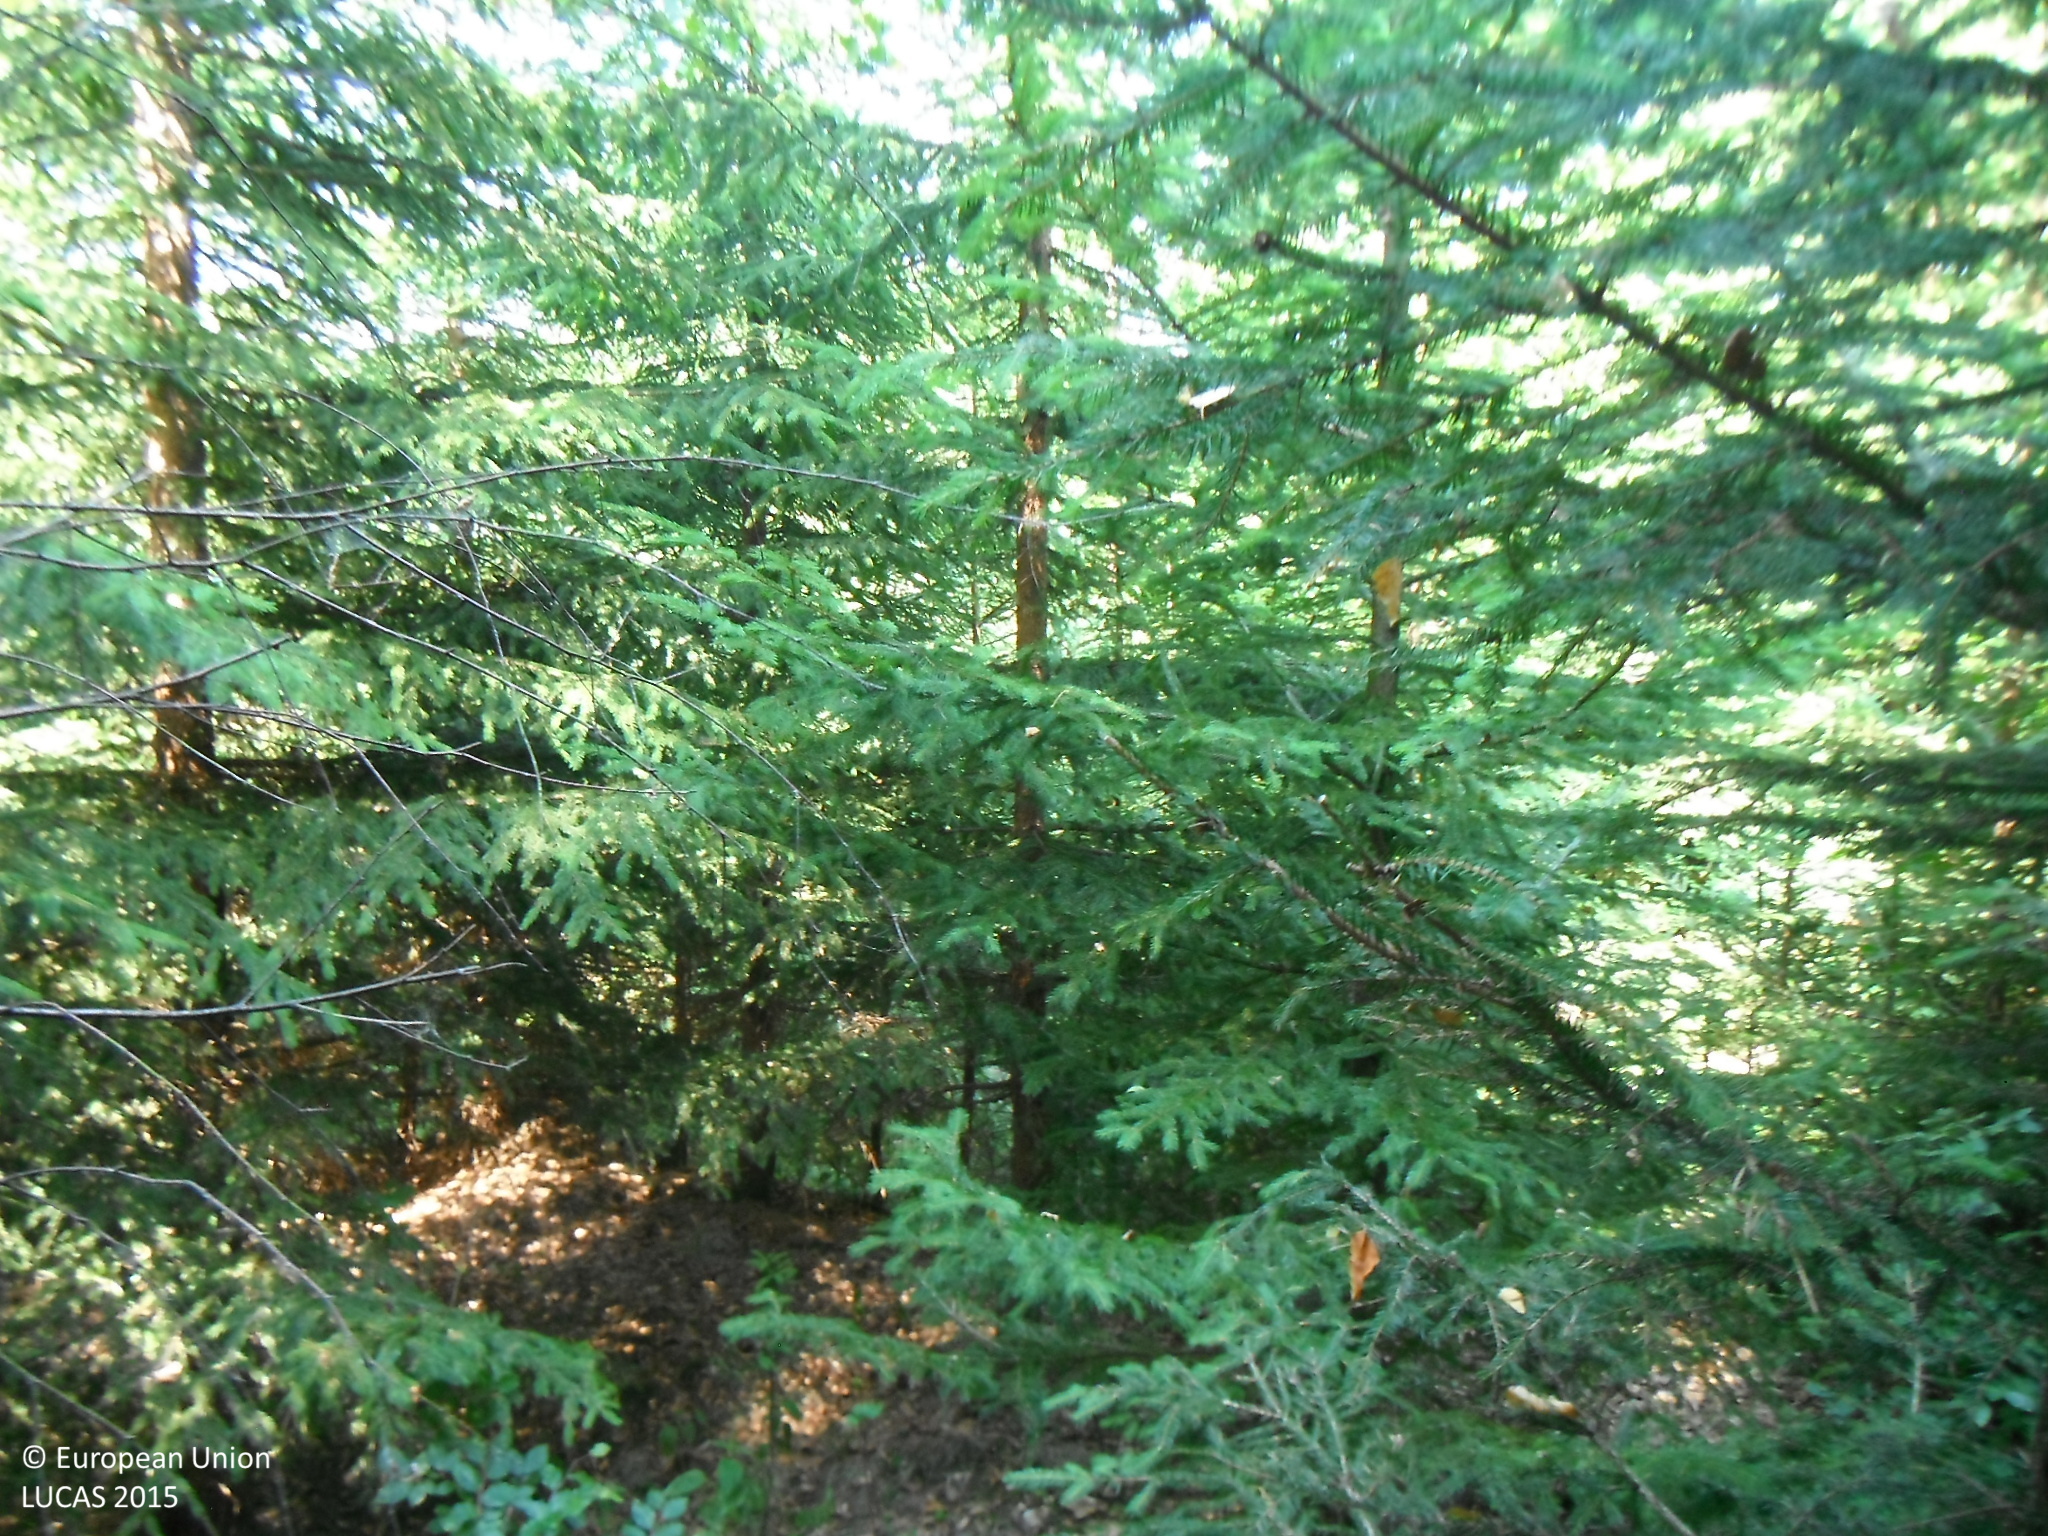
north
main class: Woodland
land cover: Spruce dominated mixed woodland
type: mesophytic deciduous forest
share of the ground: > 75 %
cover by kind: coniferous forest trees 60 %, broadleaved forest trees 35 %, herbaceous plants 5 %
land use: Forestry
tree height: > 5 m
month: August
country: SK
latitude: 49.1315
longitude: 18.1702
